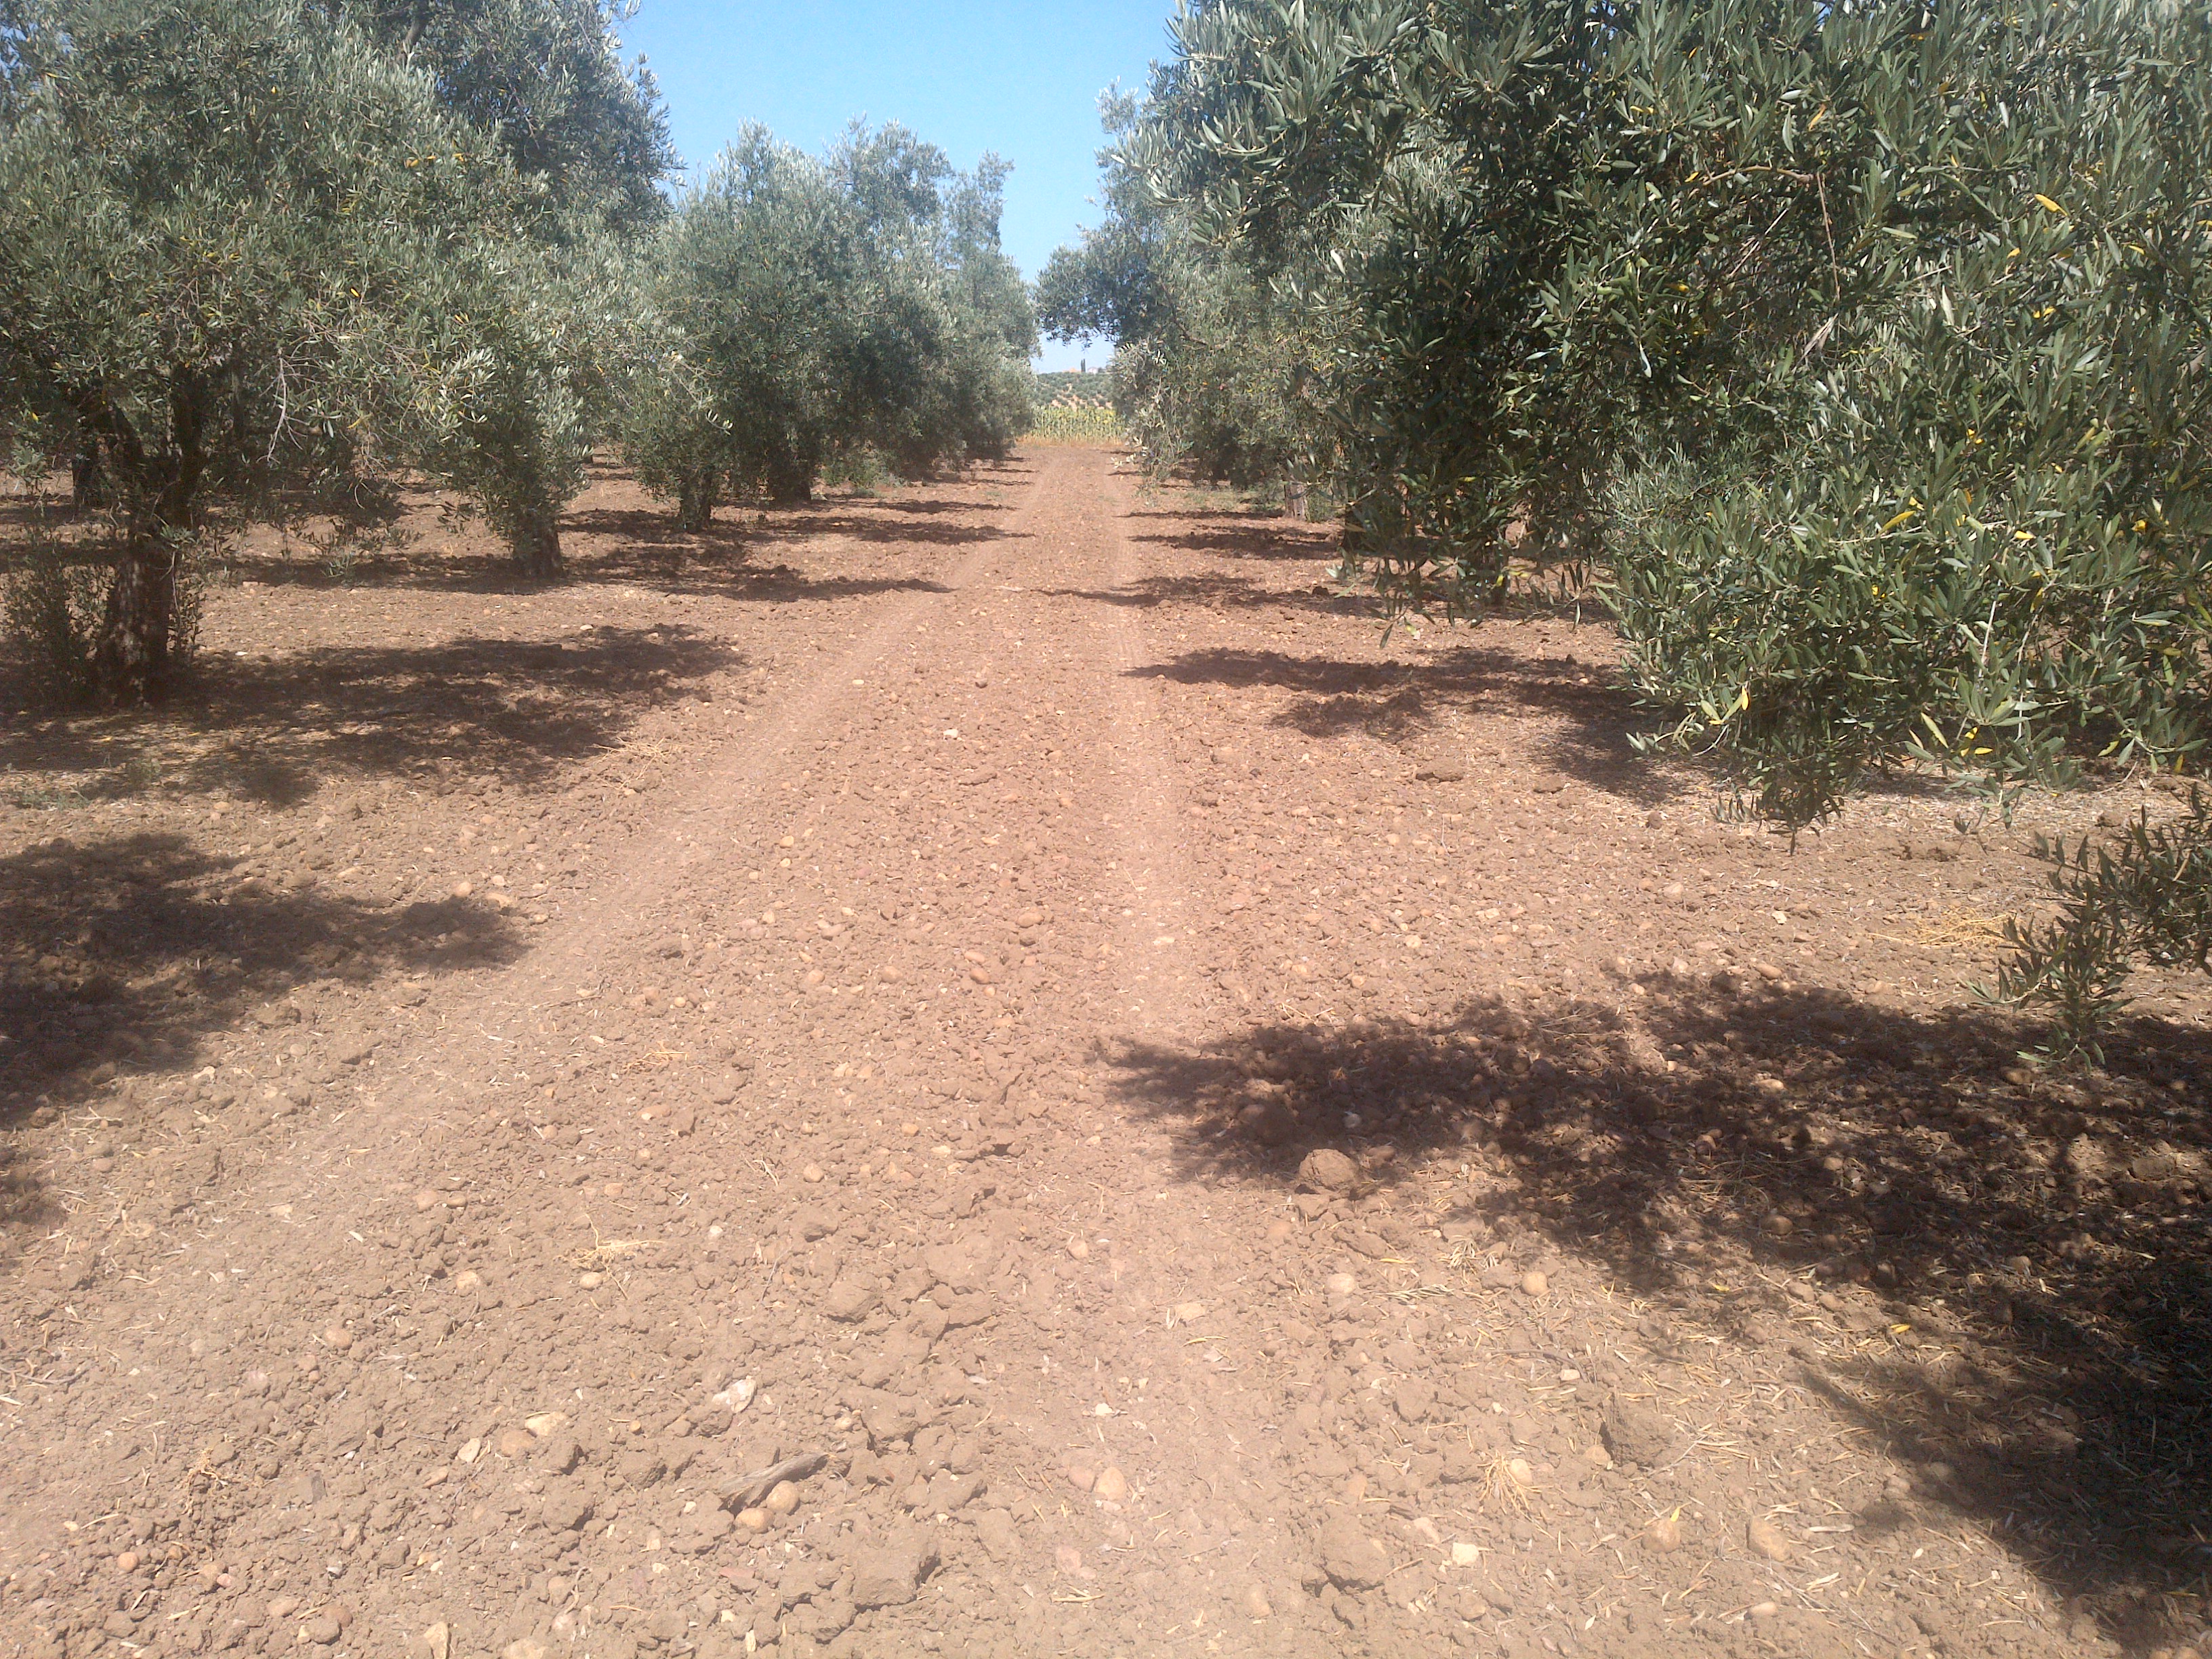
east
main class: Cropland
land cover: Olive groves
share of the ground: 50 - 75 %
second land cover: Other bare soil
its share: > 75 %
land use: Agriculture (excluding fallow land and kitchen gardens)
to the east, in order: Olive groves; Other bare soil; Grass margins; Sunflower
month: June
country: ES
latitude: 37.5854
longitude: -4.8567
